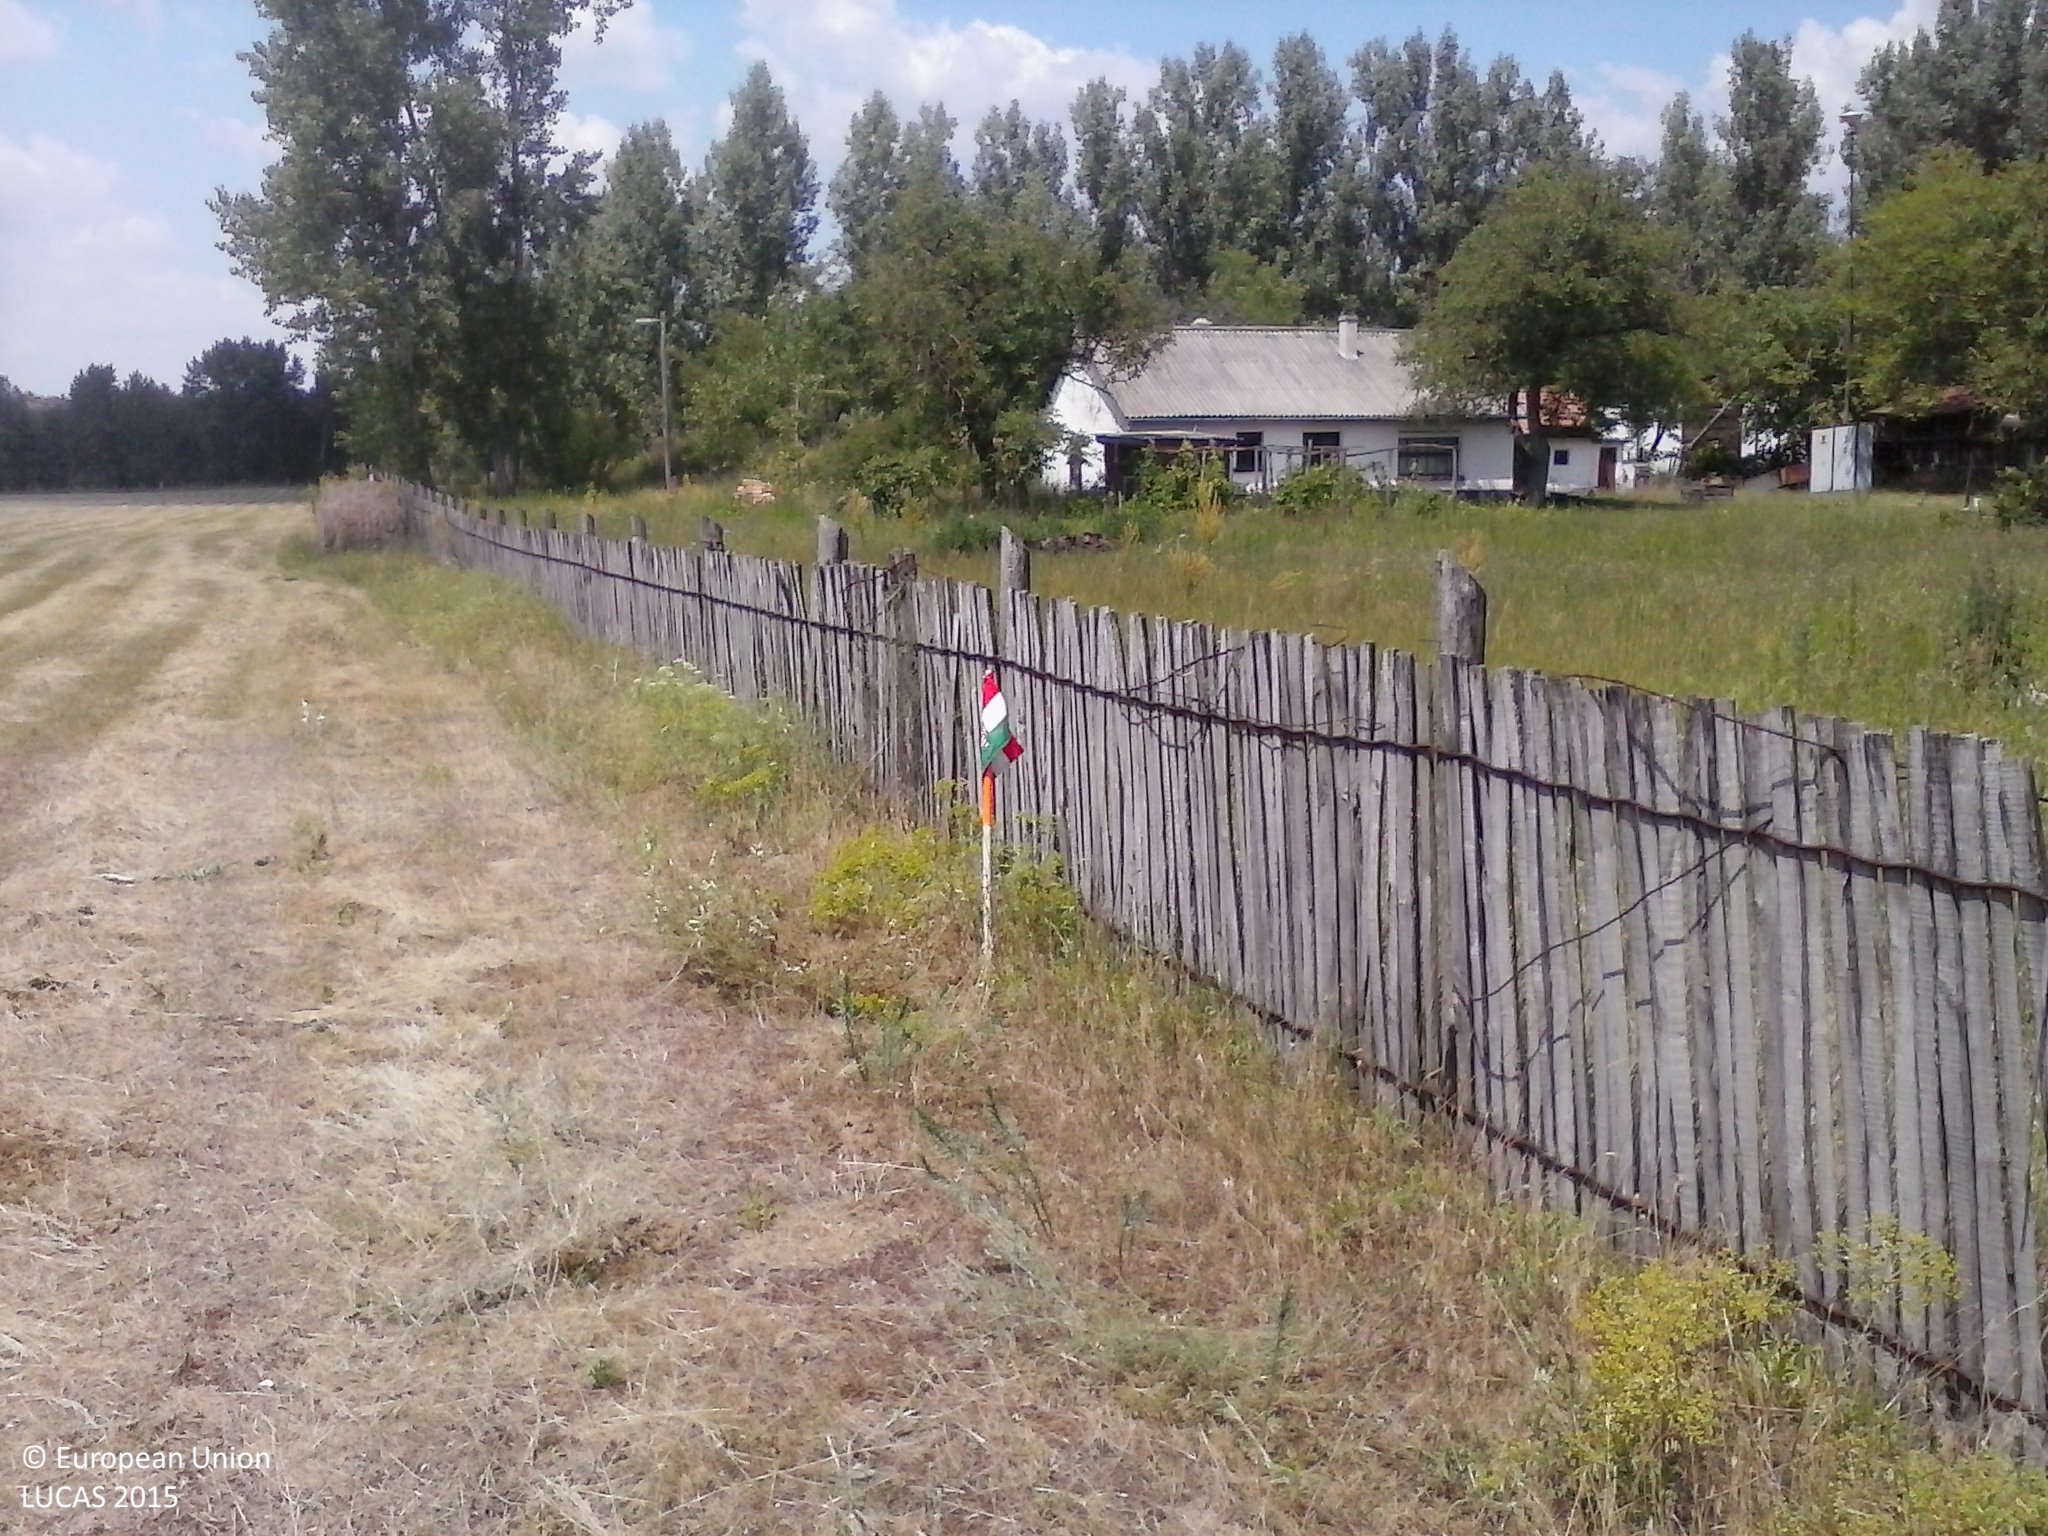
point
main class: Grassland
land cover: Grassland without tree/shrub cover
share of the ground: > 75 %
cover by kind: herbaceous plants 100 %
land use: Agriculture (excluding fallow land and kitchen gardens)
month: July
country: HU
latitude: 46.3587
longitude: 19.5437
